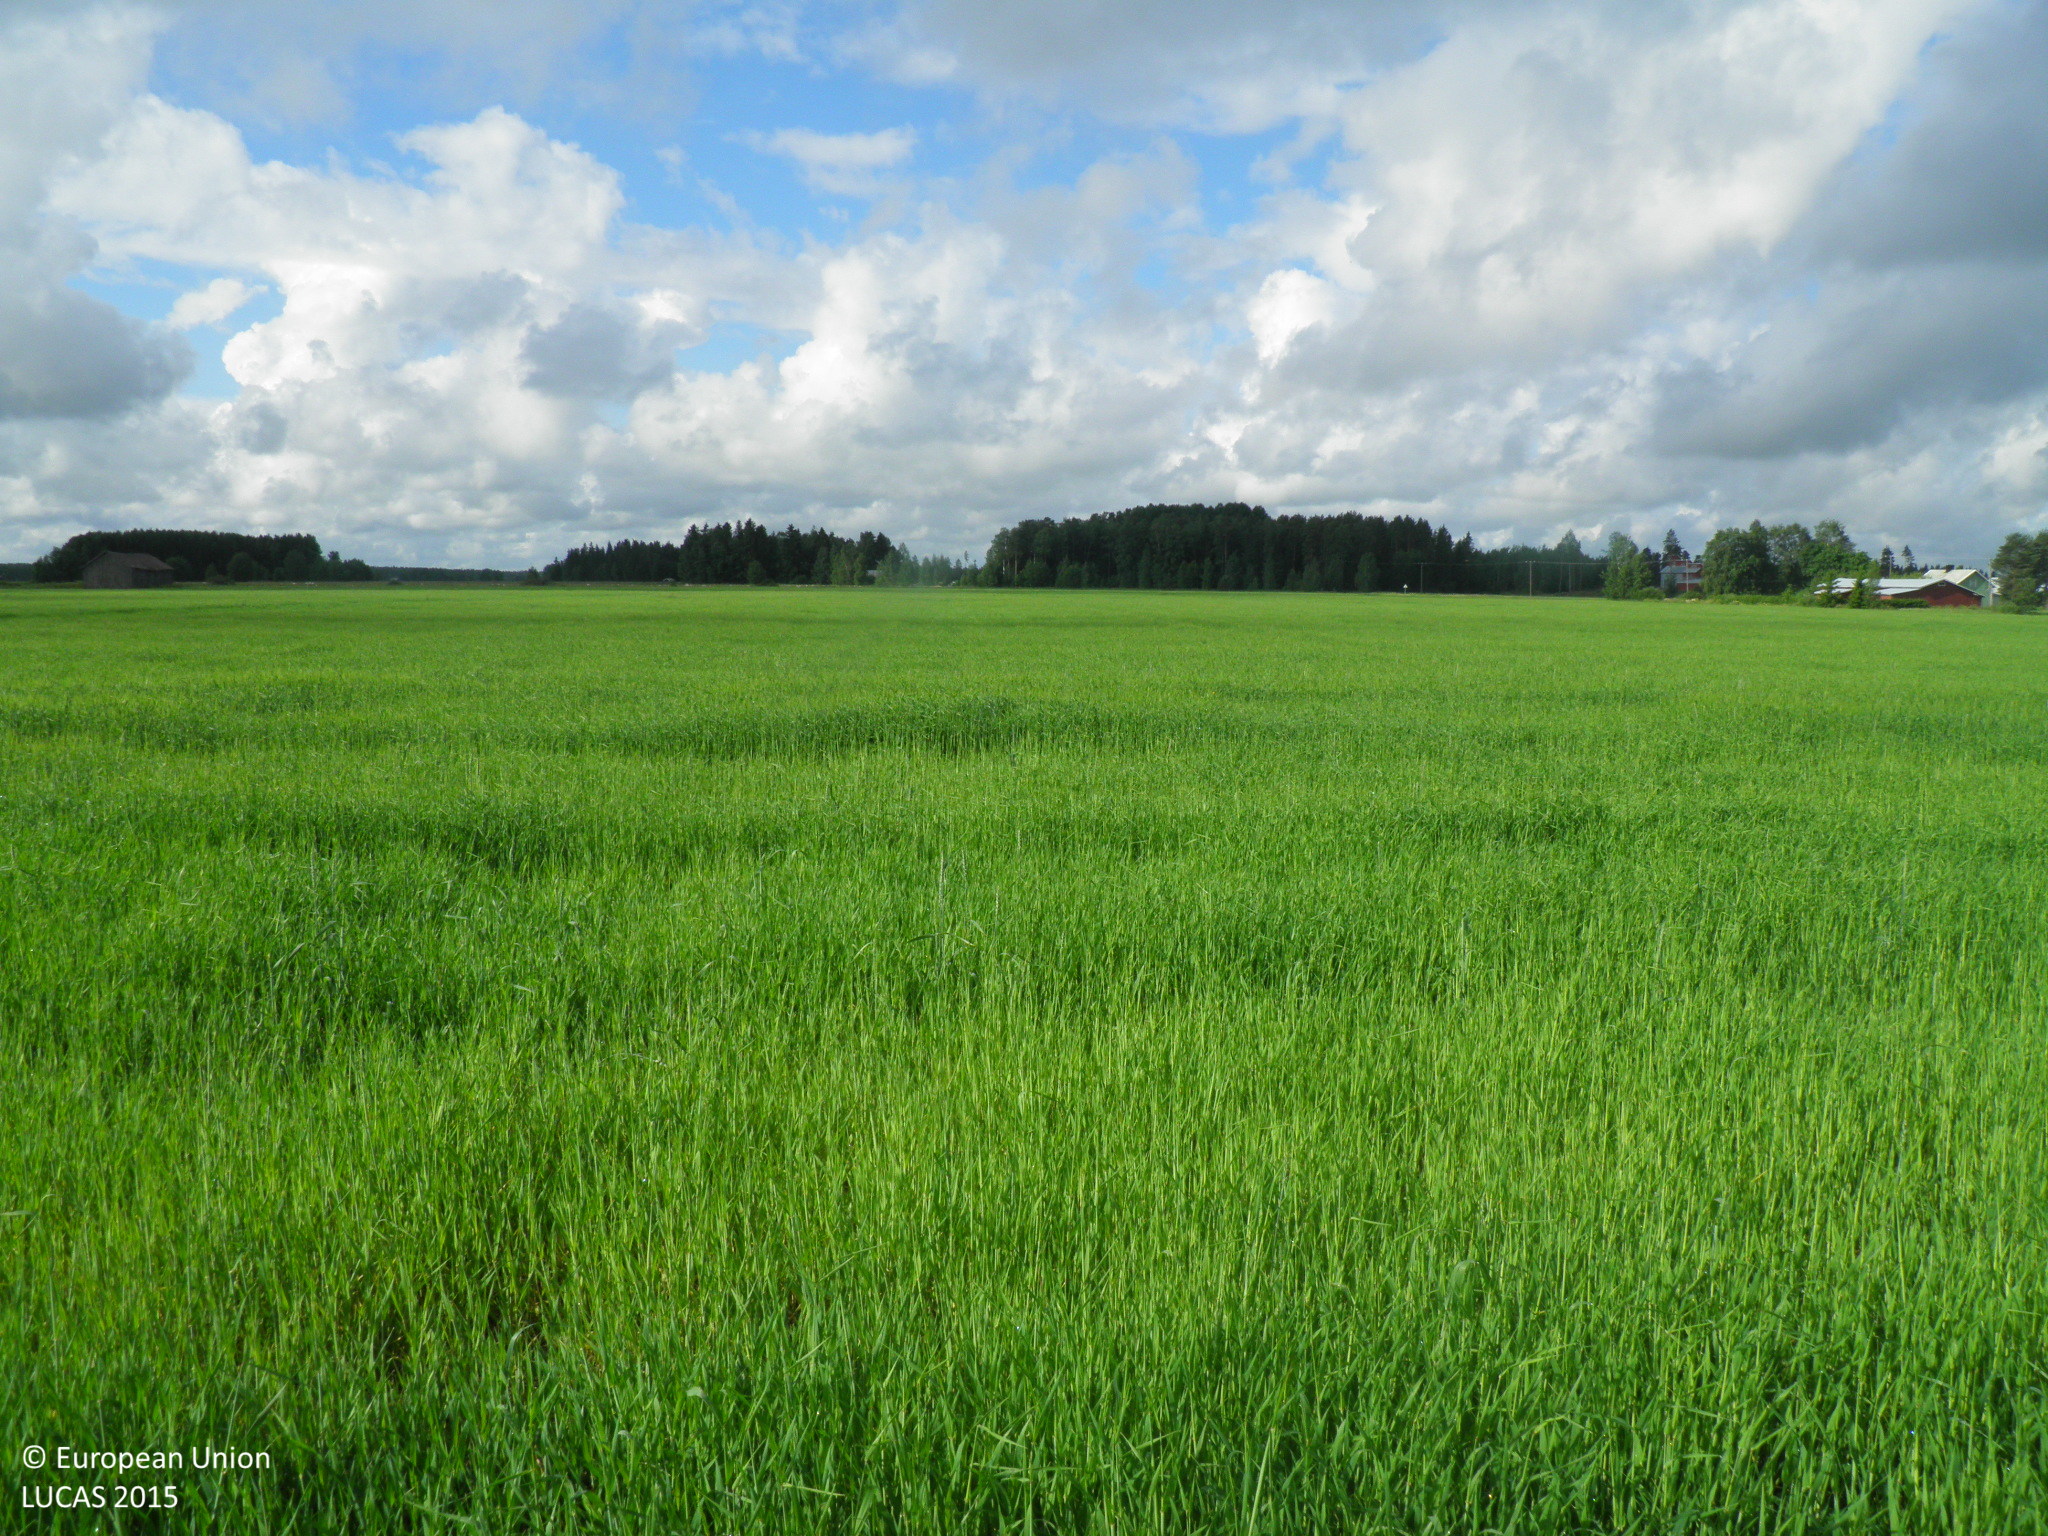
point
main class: Cropland
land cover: Barley
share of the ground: > 75 %
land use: Agriculture (excluding fallow land and kitchen gardens)
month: July
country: FI
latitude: 60.7792
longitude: 22.8363
